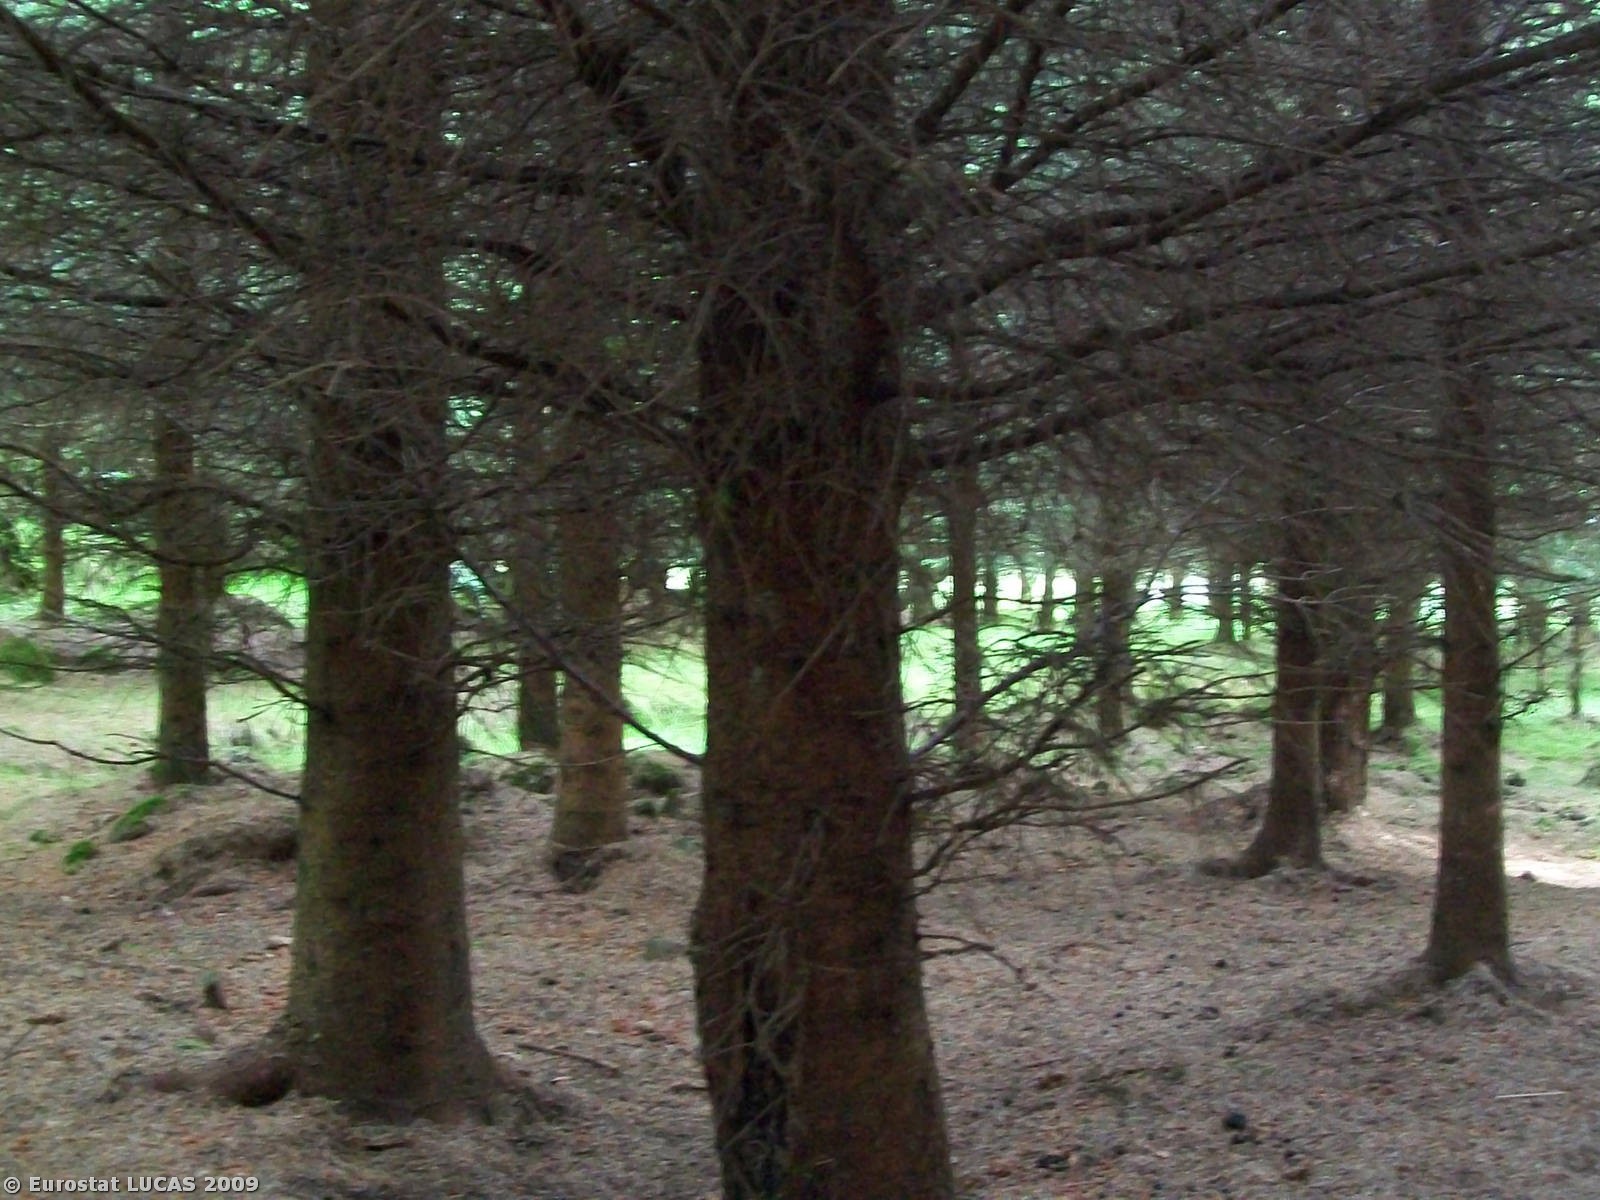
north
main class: Woodland
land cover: Coniferous woodland
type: plantations and self-sown exotic forest
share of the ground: > 75 %
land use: Forestry
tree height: > 5 m
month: July
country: GB
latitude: 54.8975
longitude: -6.8334
